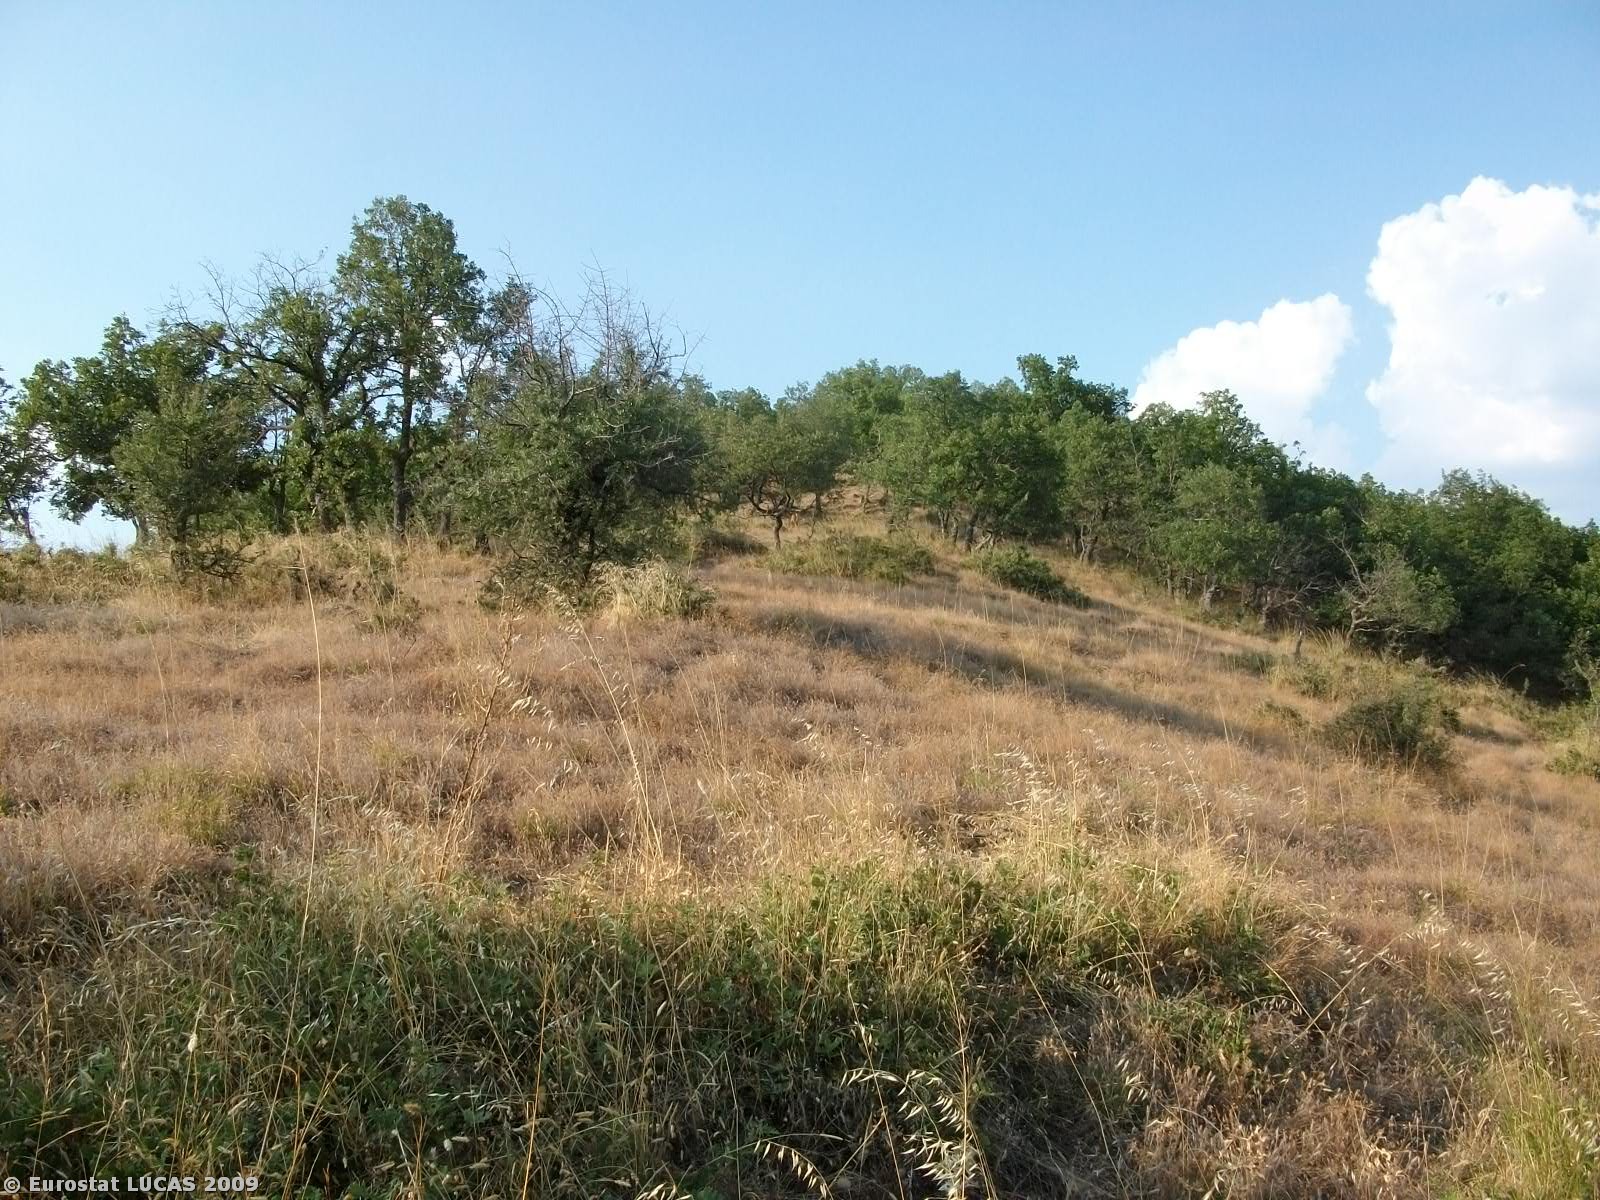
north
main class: Grassland
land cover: Grassland with sparse tree/shrub cover
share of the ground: > 75 %
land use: Unused
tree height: > 5 m
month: August
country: GR
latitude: 39.7541
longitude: 21.6445
